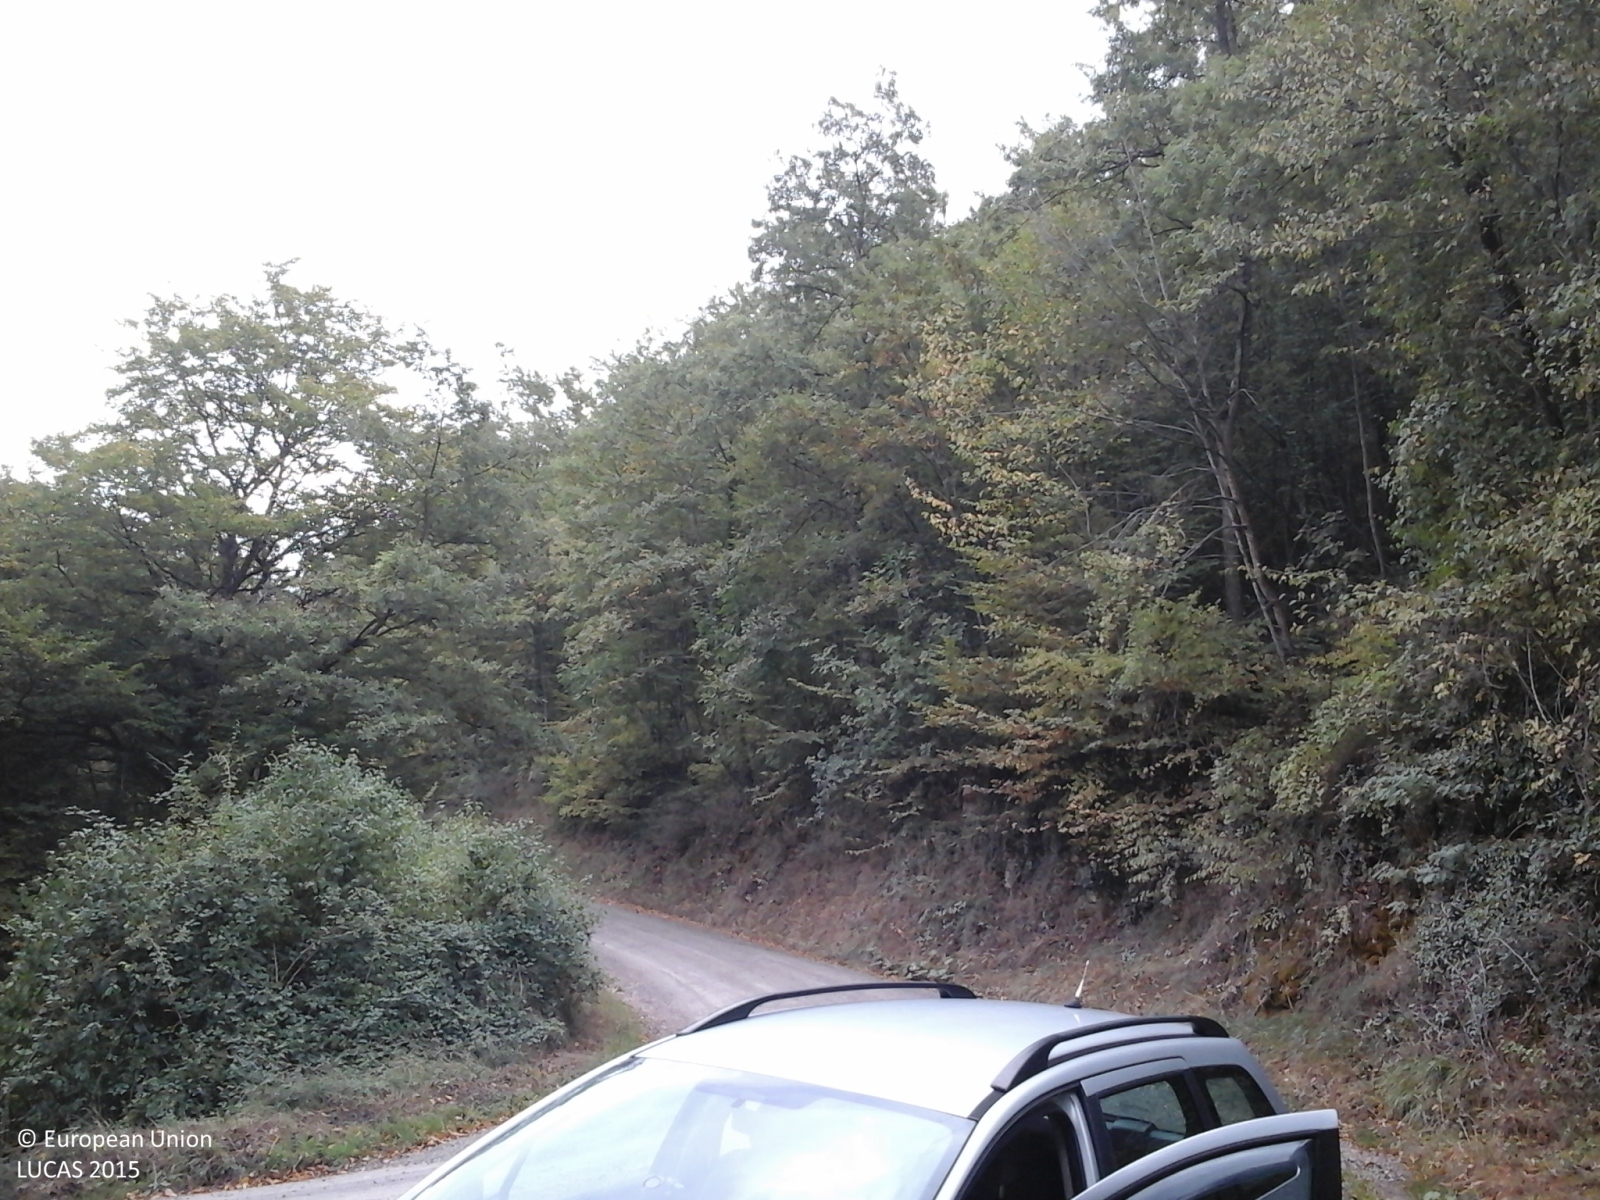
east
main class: Woodland
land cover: Broadleaved woodland
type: thermophilous deciduous forest
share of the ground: > 75 %
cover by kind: broadleaved forest trees 85 %, shrubs 10 %, herbaceous plants 5 %
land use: Forestry
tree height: > 5 m
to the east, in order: Broadleaved woodland
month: October
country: IT
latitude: 43.1863
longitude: 12.3679
